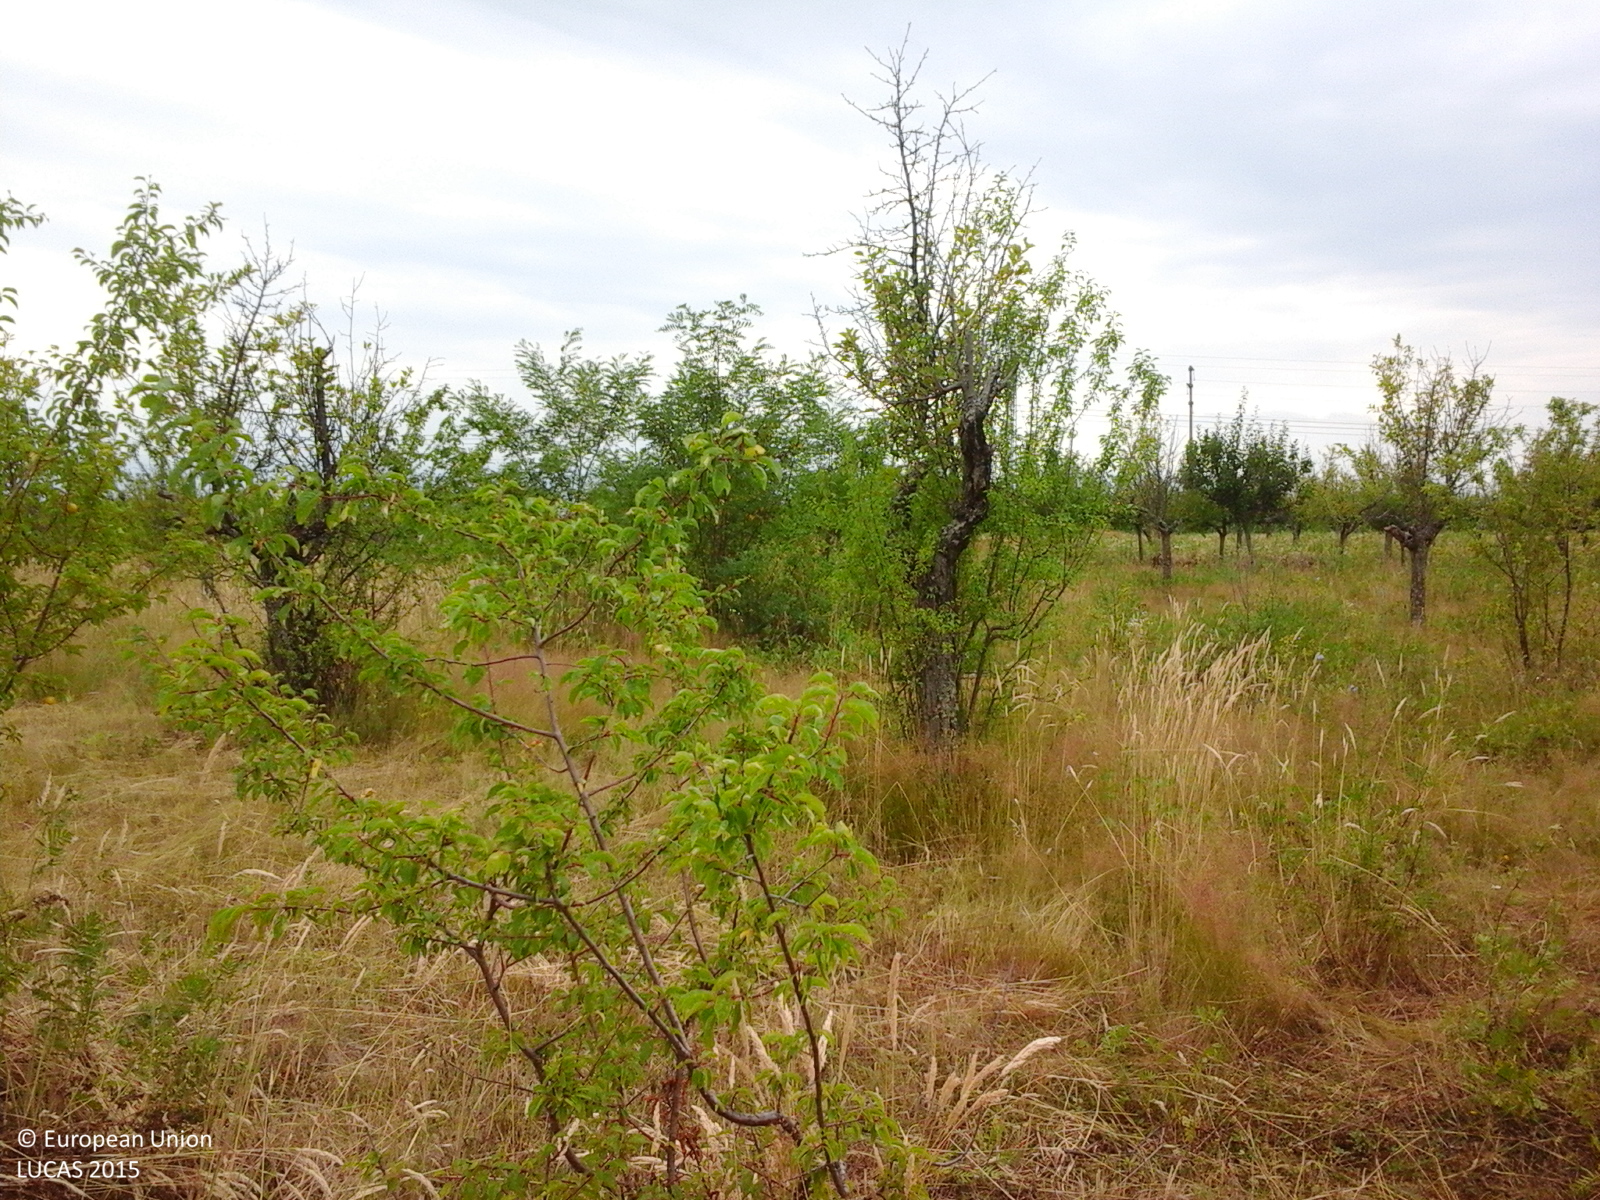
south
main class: Cropland
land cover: Other fruit trees and berries
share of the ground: > 75 %
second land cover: Grassland without tree/shrub cover
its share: > 75 %
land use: Agriculture (excluding fallow land and kitchen gardens)
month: July
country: RO
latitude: 44.8007
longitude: 24.4210
